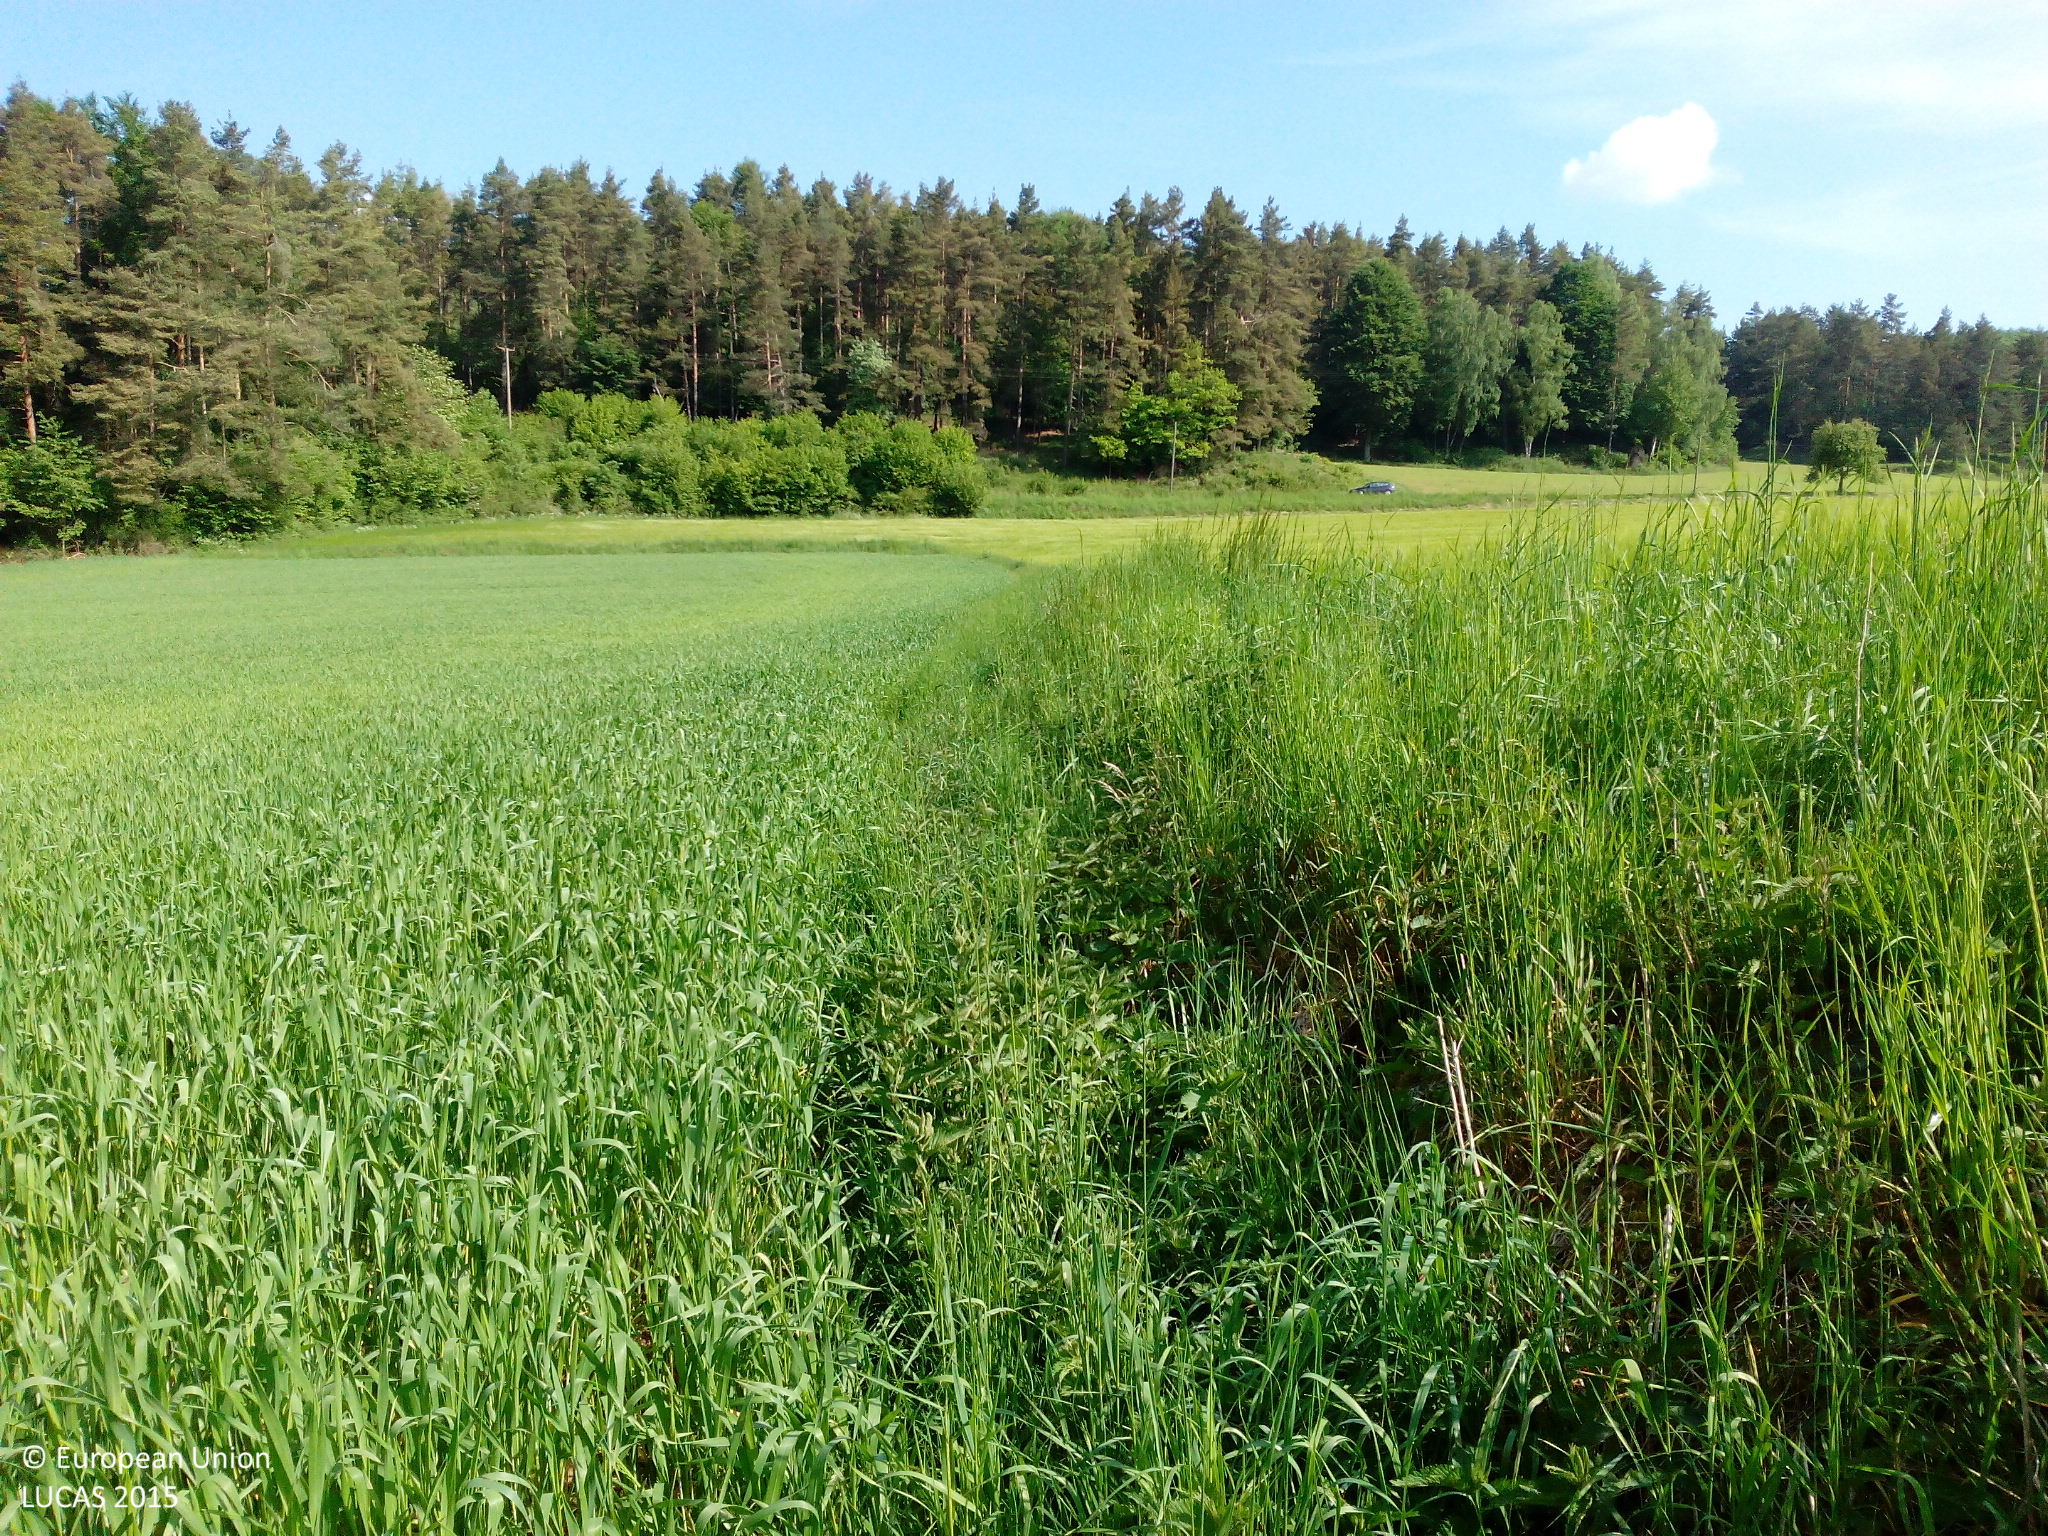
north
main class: Cropland
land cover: Triticale
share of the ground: > 75 %
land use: Agriculture (excluding fallow land and kitchen gardens)
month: May
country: DE
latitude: 49.4357
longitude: 11.5853
